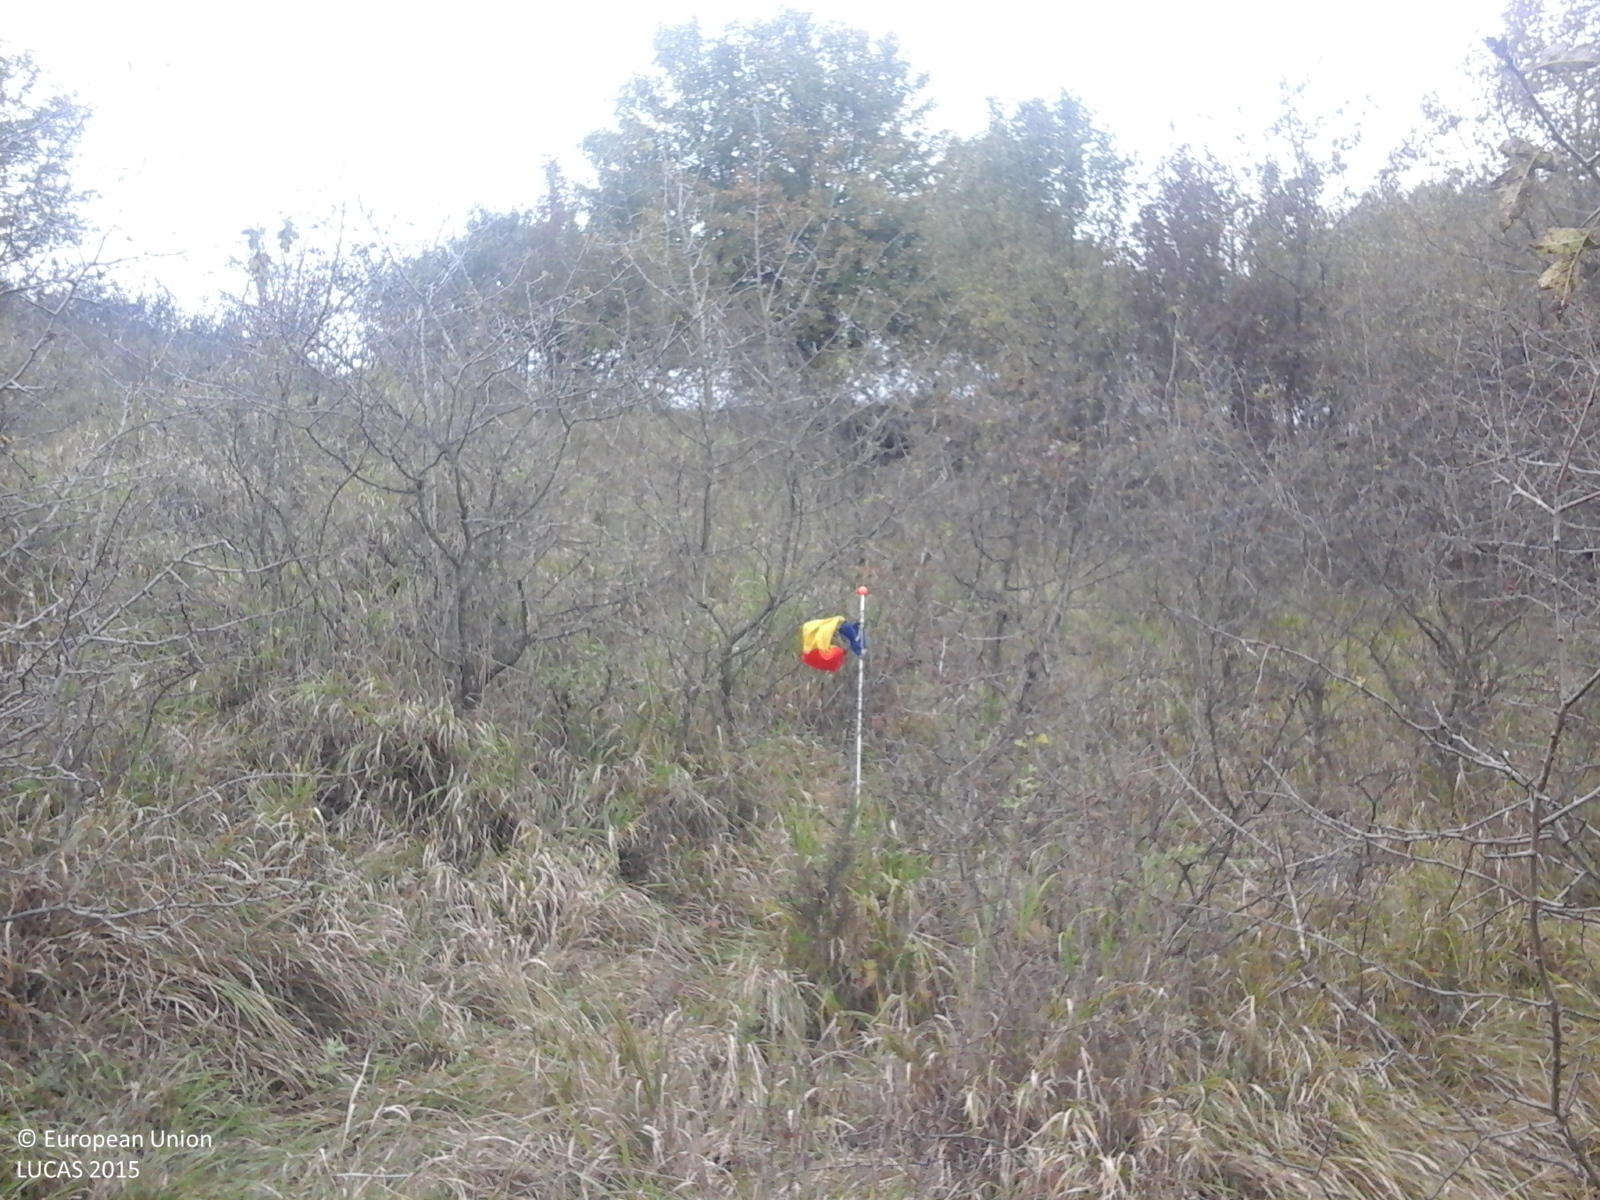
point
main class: Shrubland
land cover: Shrubland with sparse tree cover
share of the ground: > 75 %
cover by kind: shrubs 60 %, herbaceous plants 35 %, broadleaved forest trees 5 %
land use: Fallow land
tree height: < 5 m
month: October
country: RO
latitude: 46.1081
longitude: 25.0119
